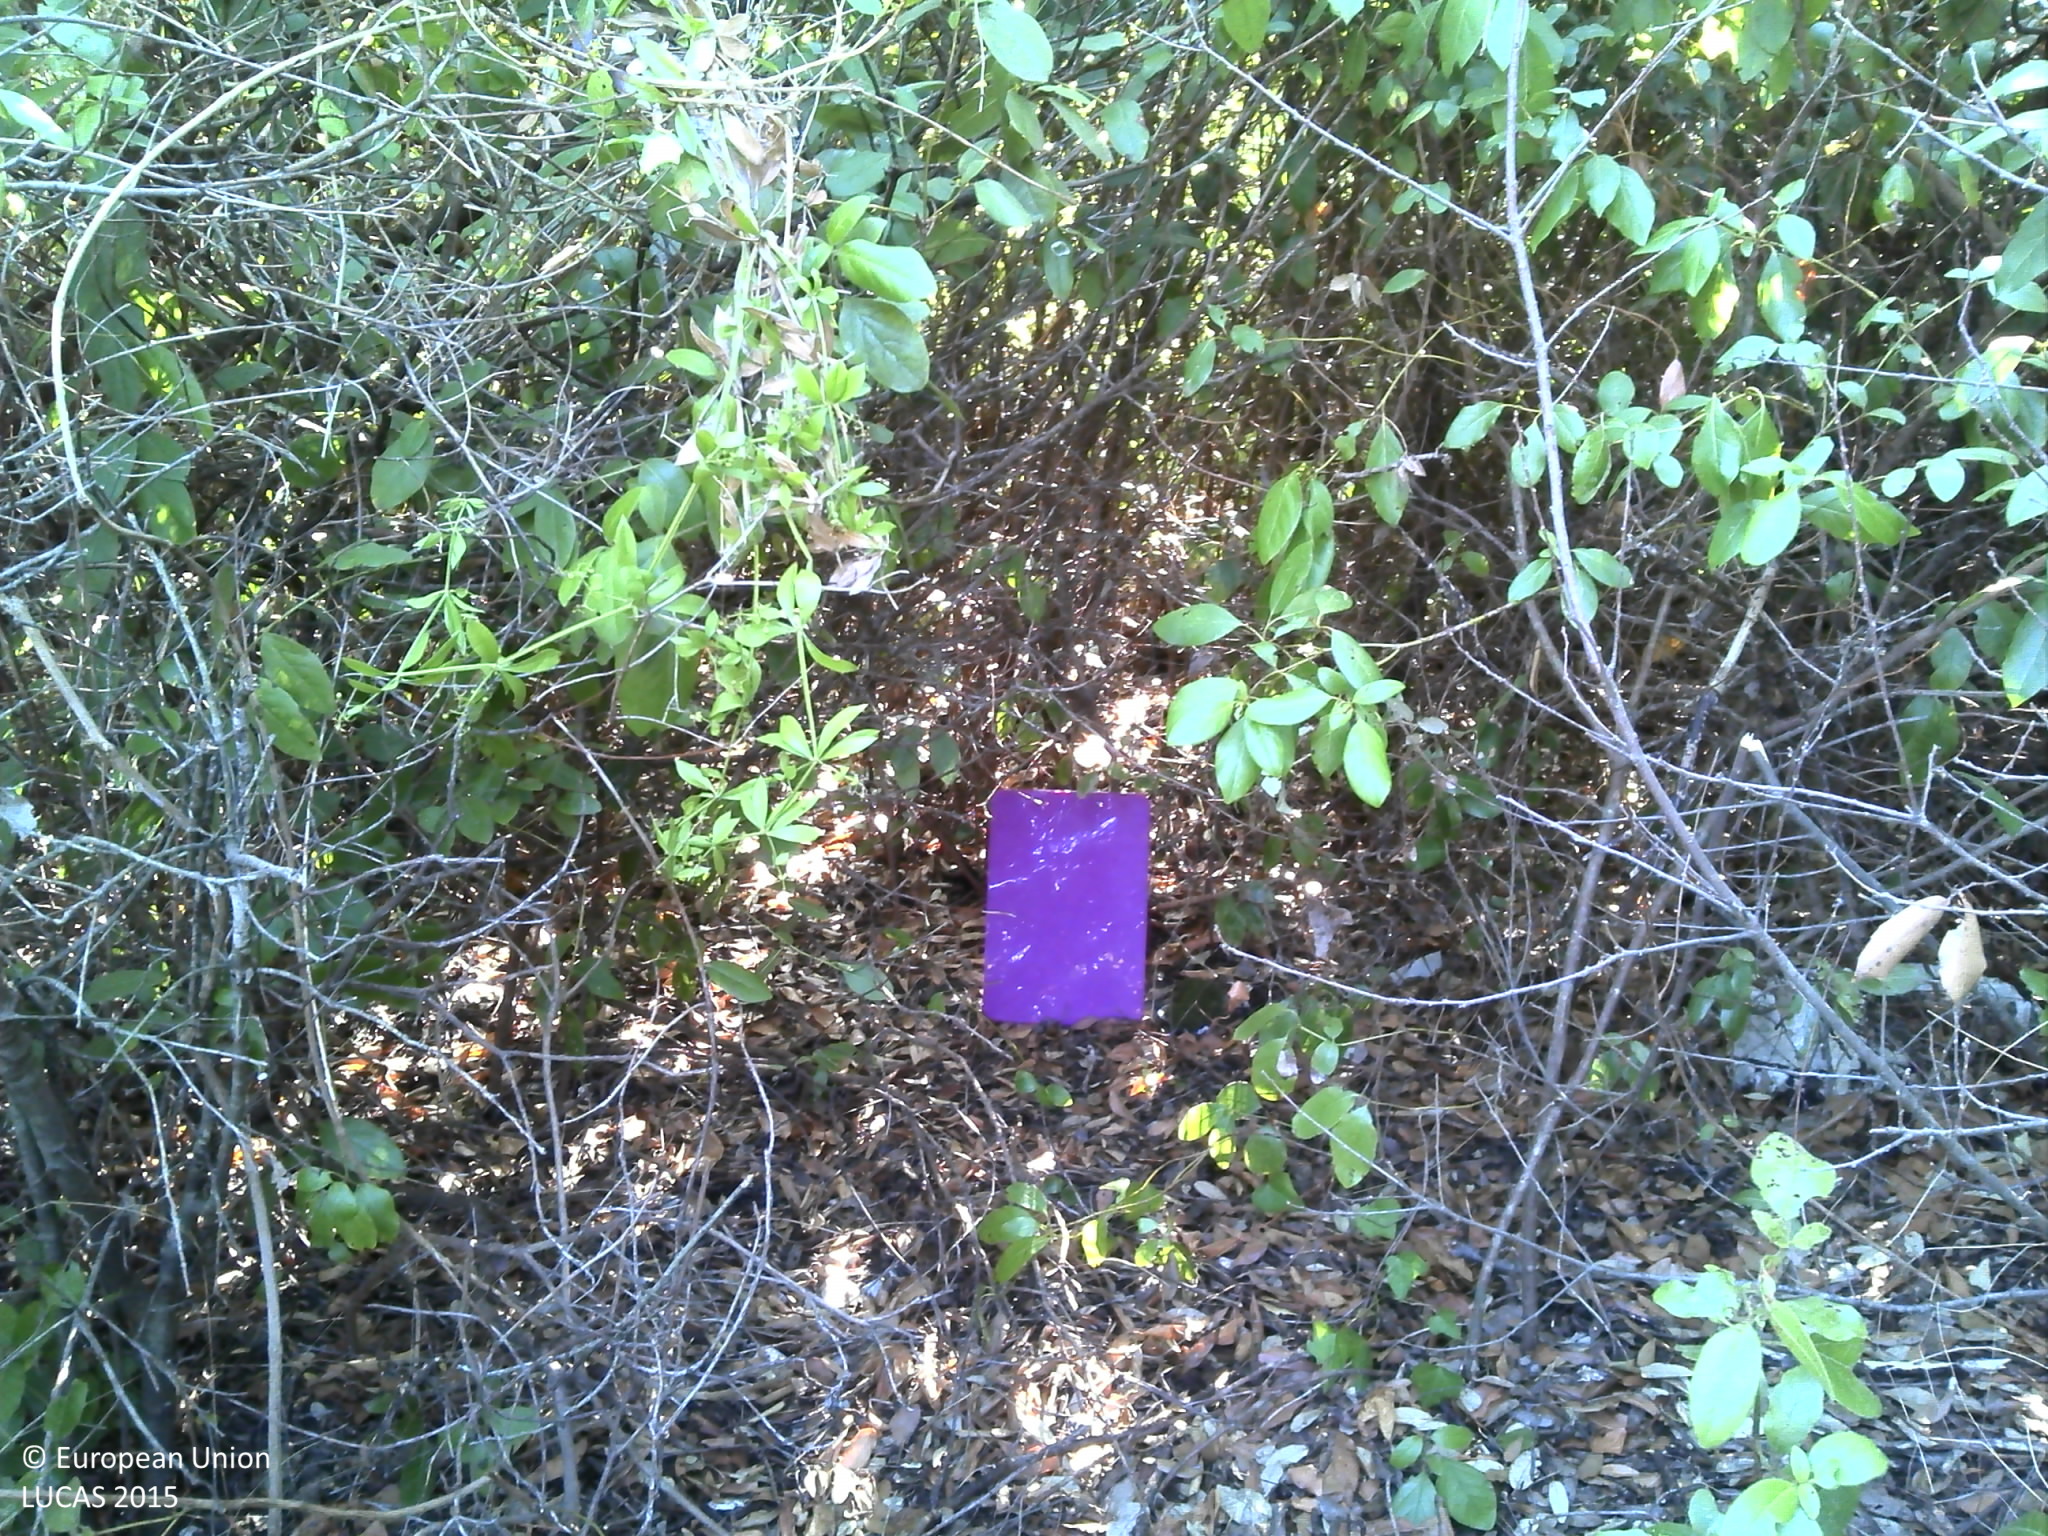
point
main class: Woodland
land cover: Other mixed woodland
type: coniferous forest of the mediterranean region
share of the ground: 25 - 50 %
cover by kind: shrubs 40 %, coniferous forest trees 30 %, broadleaved forest trees 20 %, unconsolidated bare surface 10 %
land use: Semi-natural and natural areas not in use
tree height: > 5 m
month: August
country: HR
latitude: 42.9296
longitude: 17.1081
